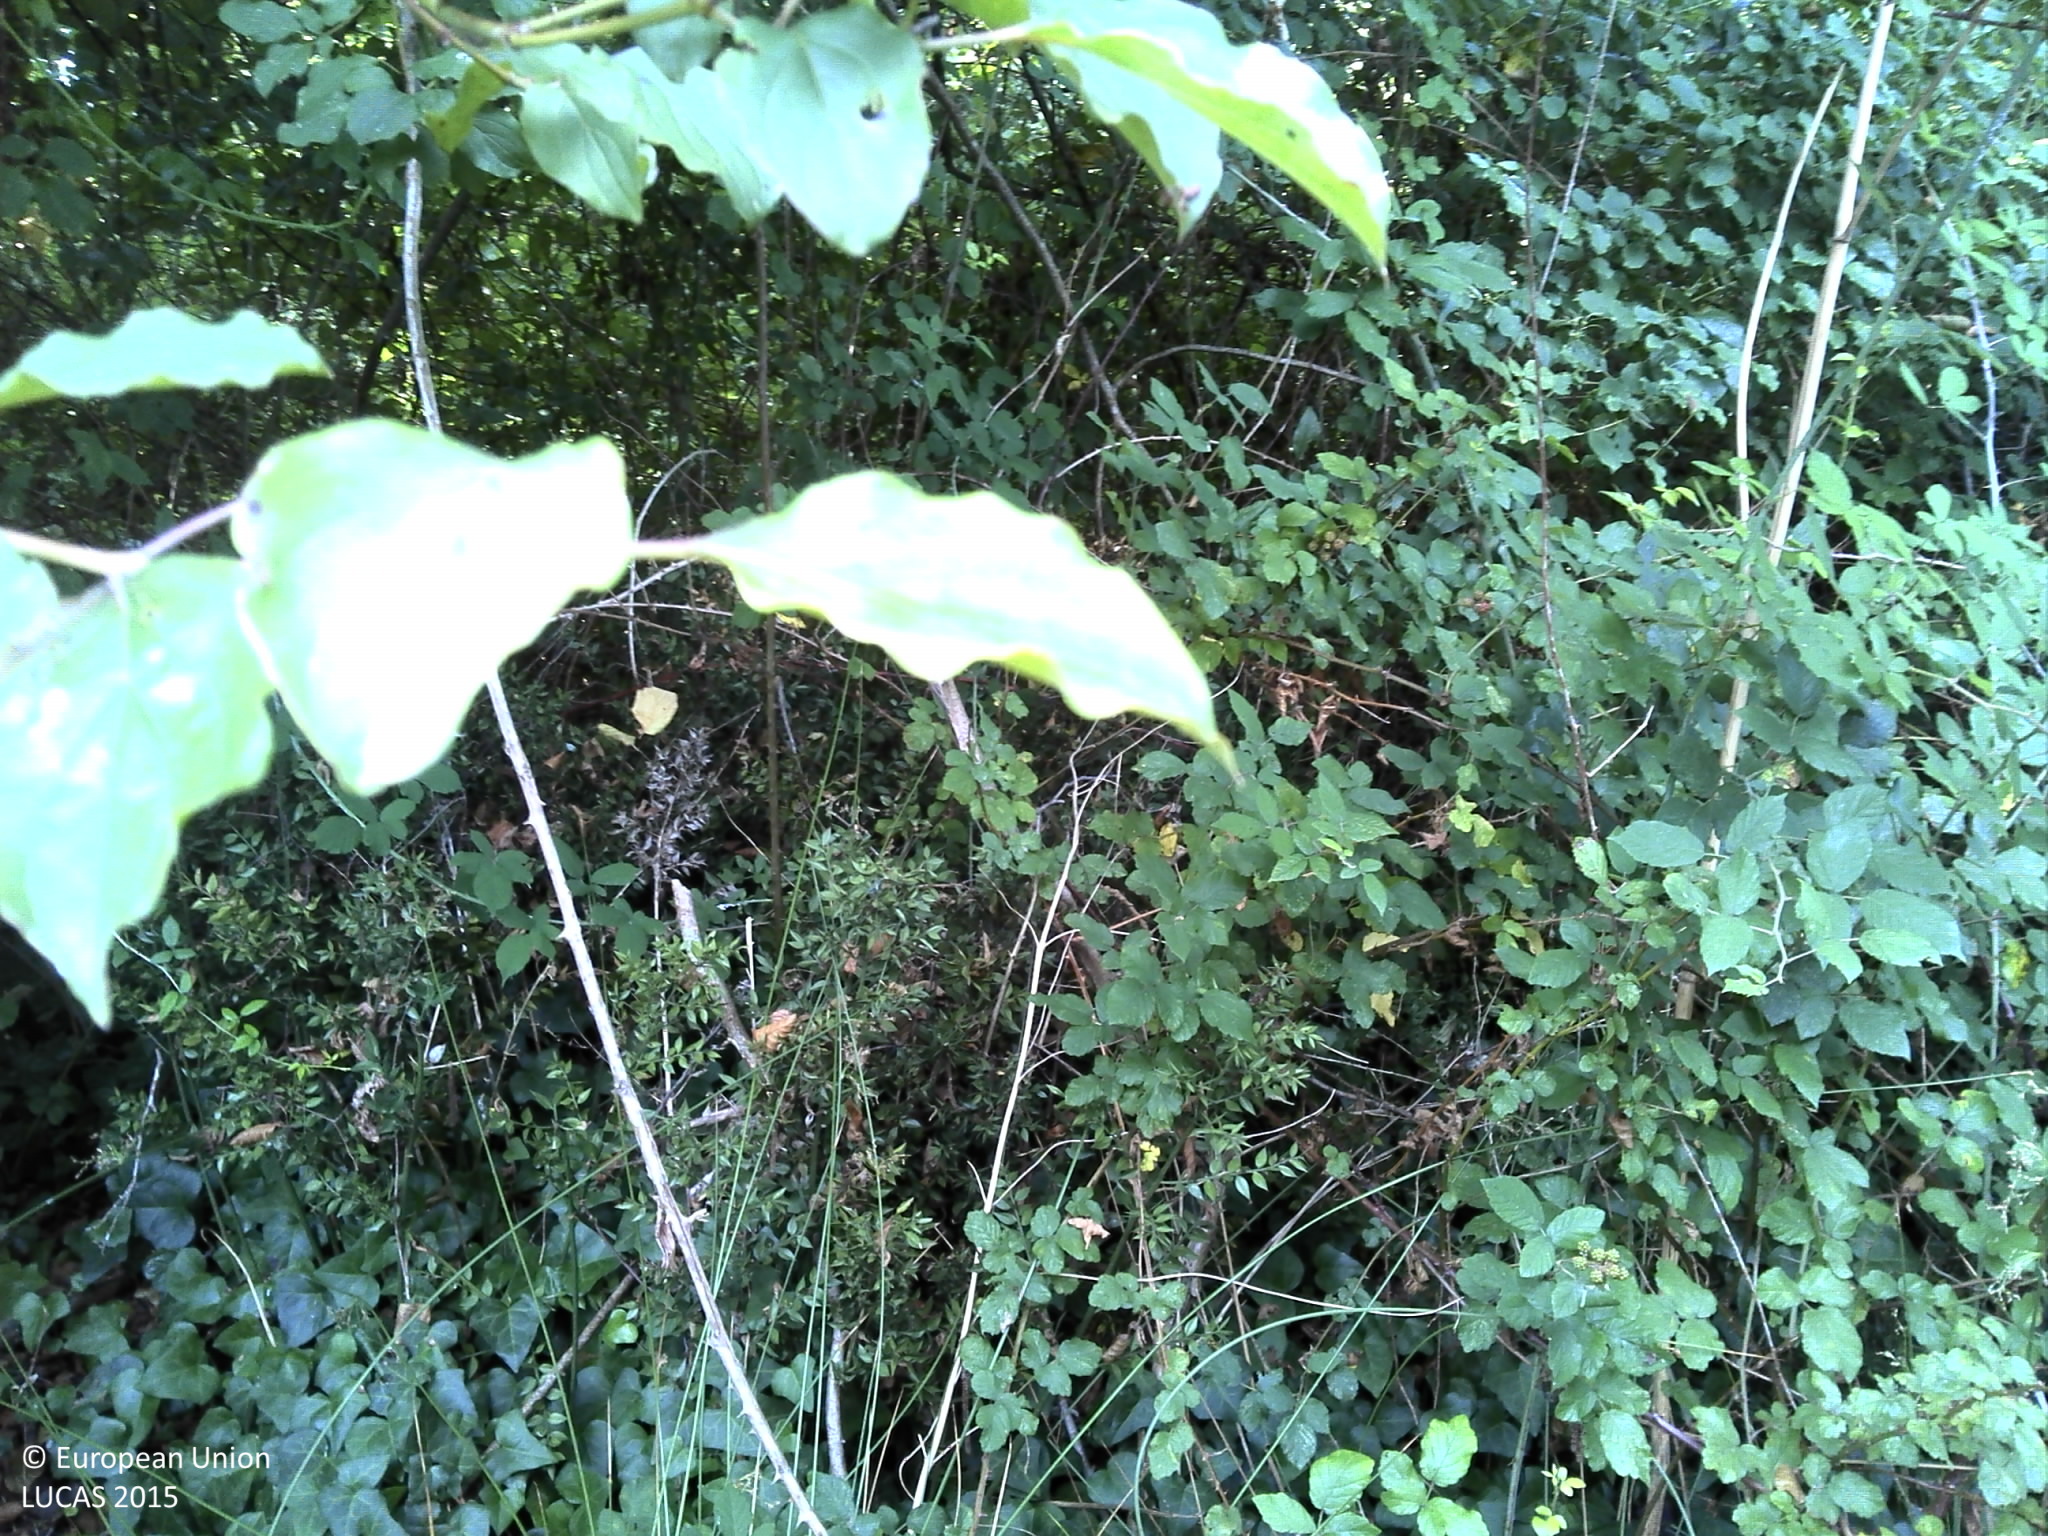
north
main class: Woodland
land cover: Broadleaved woodland
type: floodplain forest
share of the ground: > 75 %
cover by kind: broadleaved forest trees 100 %
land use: Semi-natural and natural areas not in use
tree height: > 5 m
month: August
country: FR
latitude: 45.0169
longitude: -0.6670
